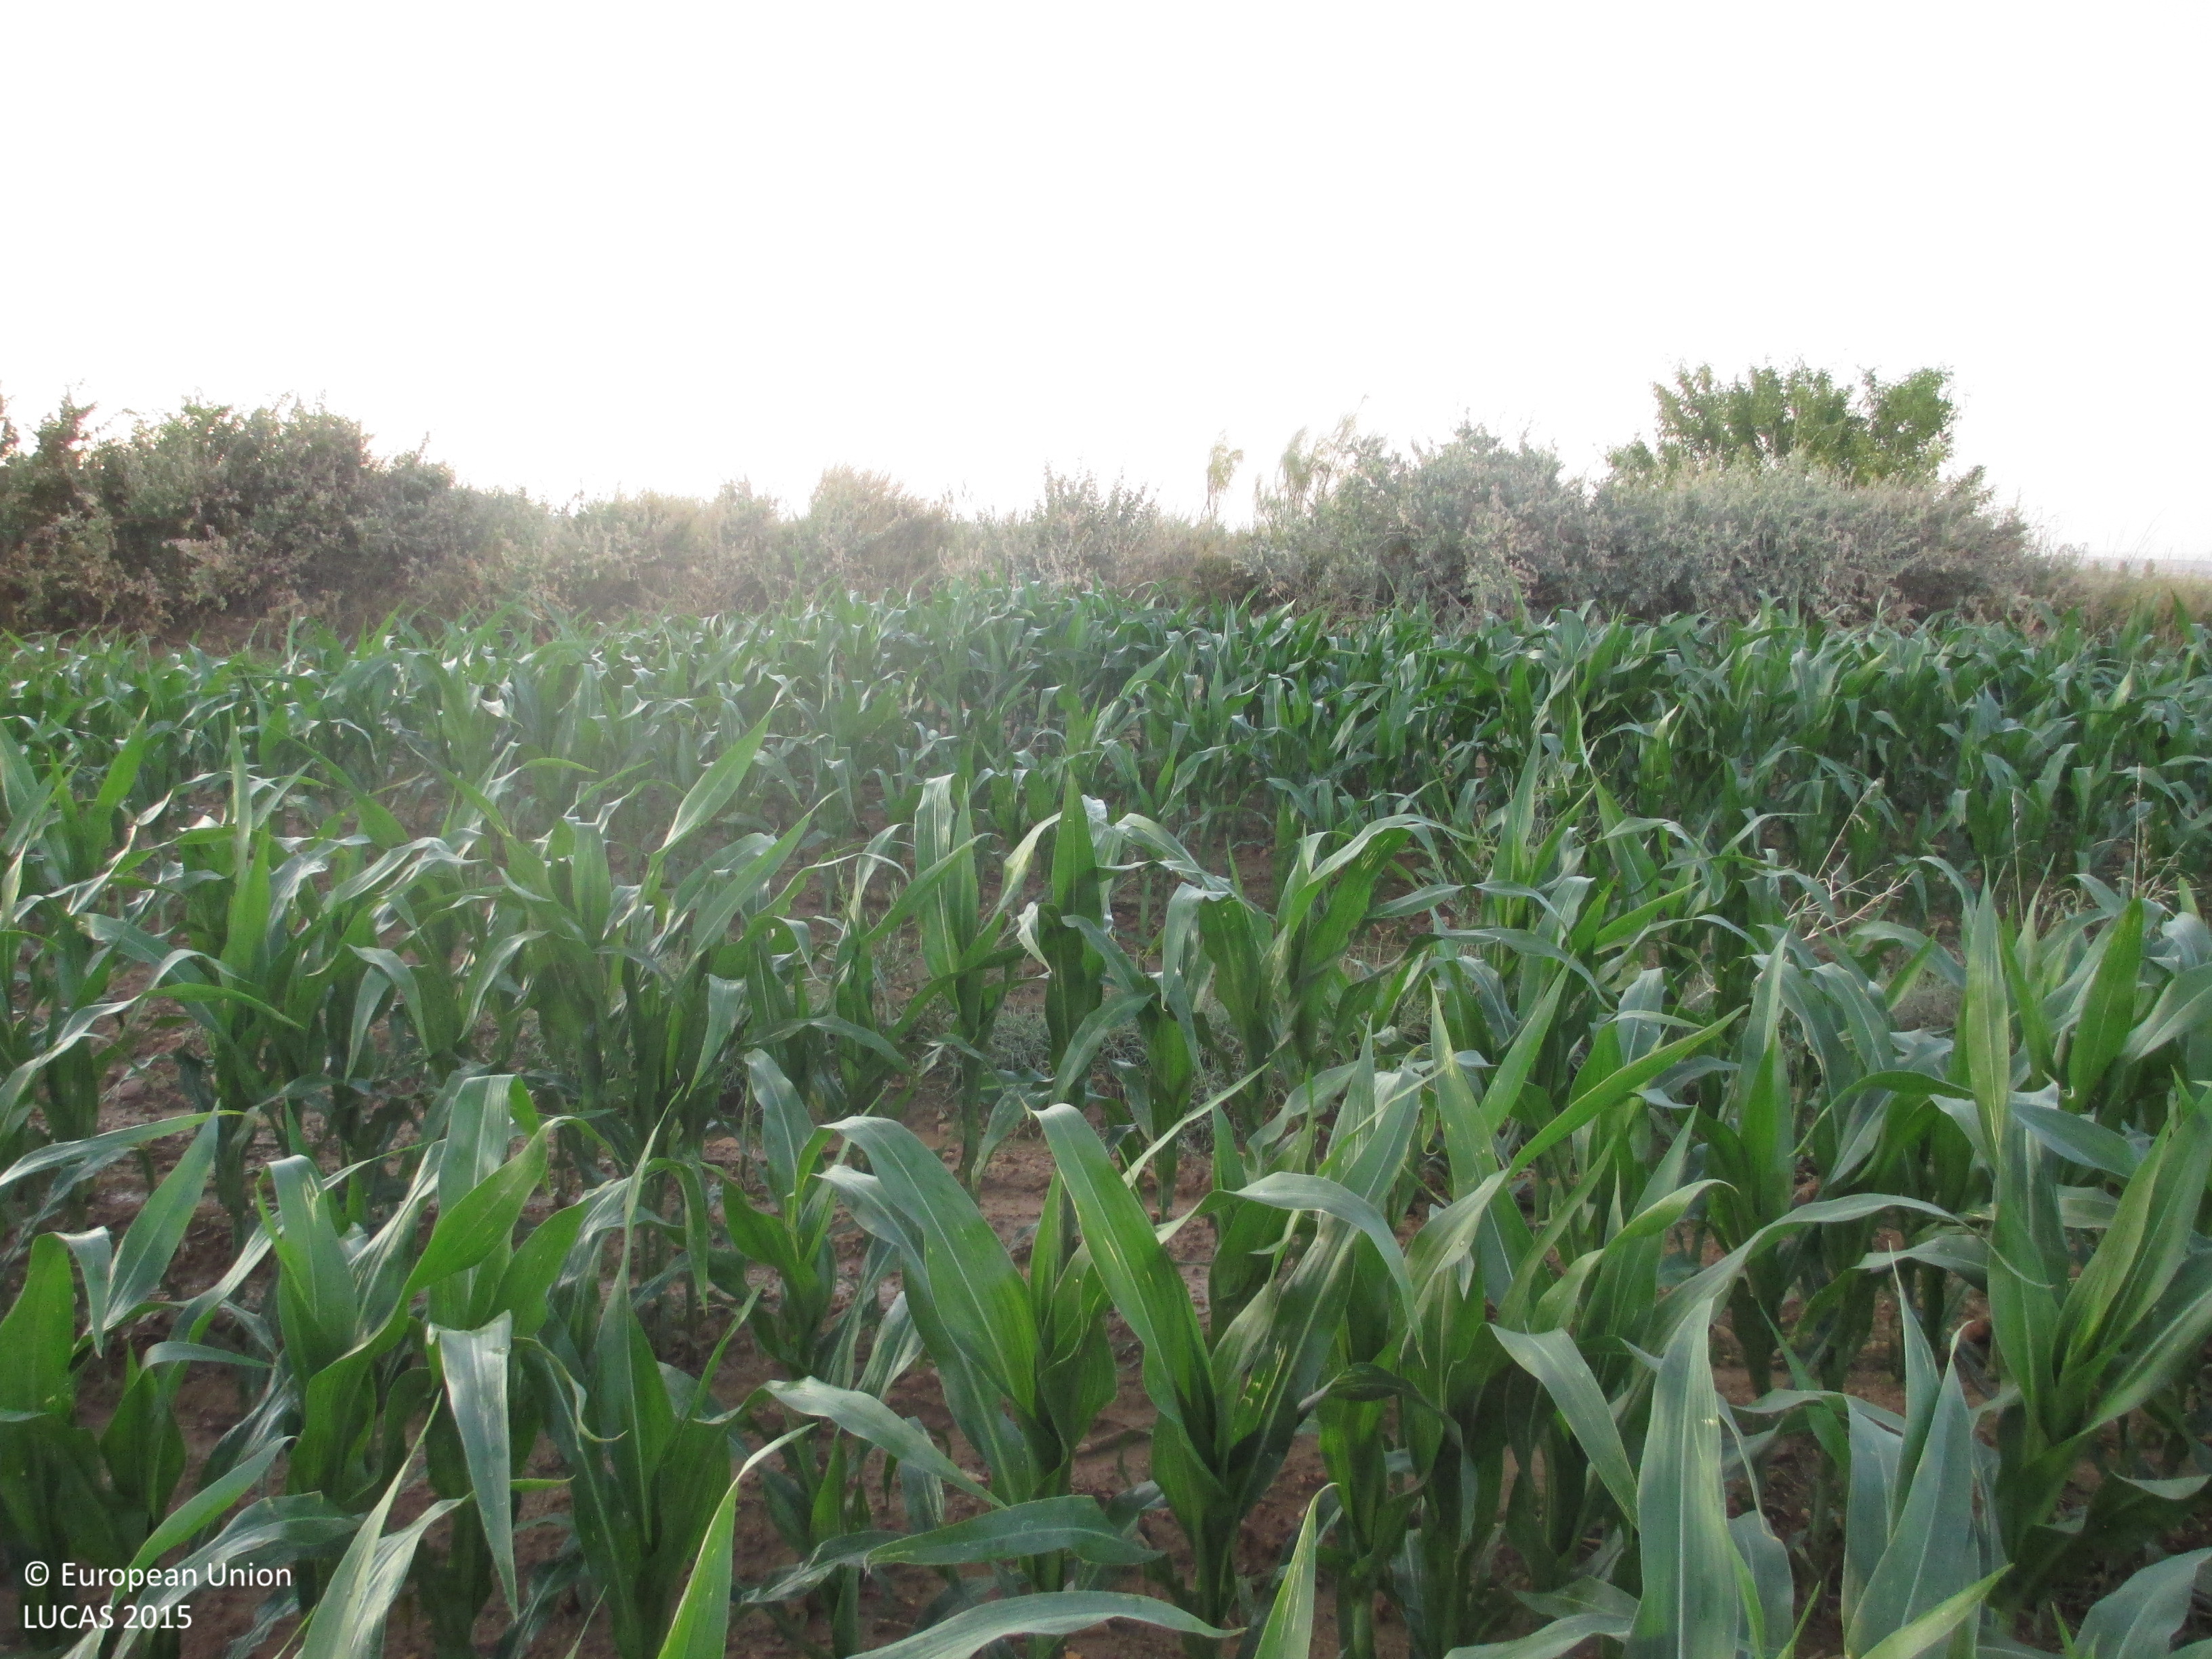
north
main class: Cropland
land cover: Maize
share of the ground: > 75 %
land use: Agriculture (excluding fallow land and kitchen gardens)
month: July
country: ES
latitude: 41.8891
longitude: 0.0396
